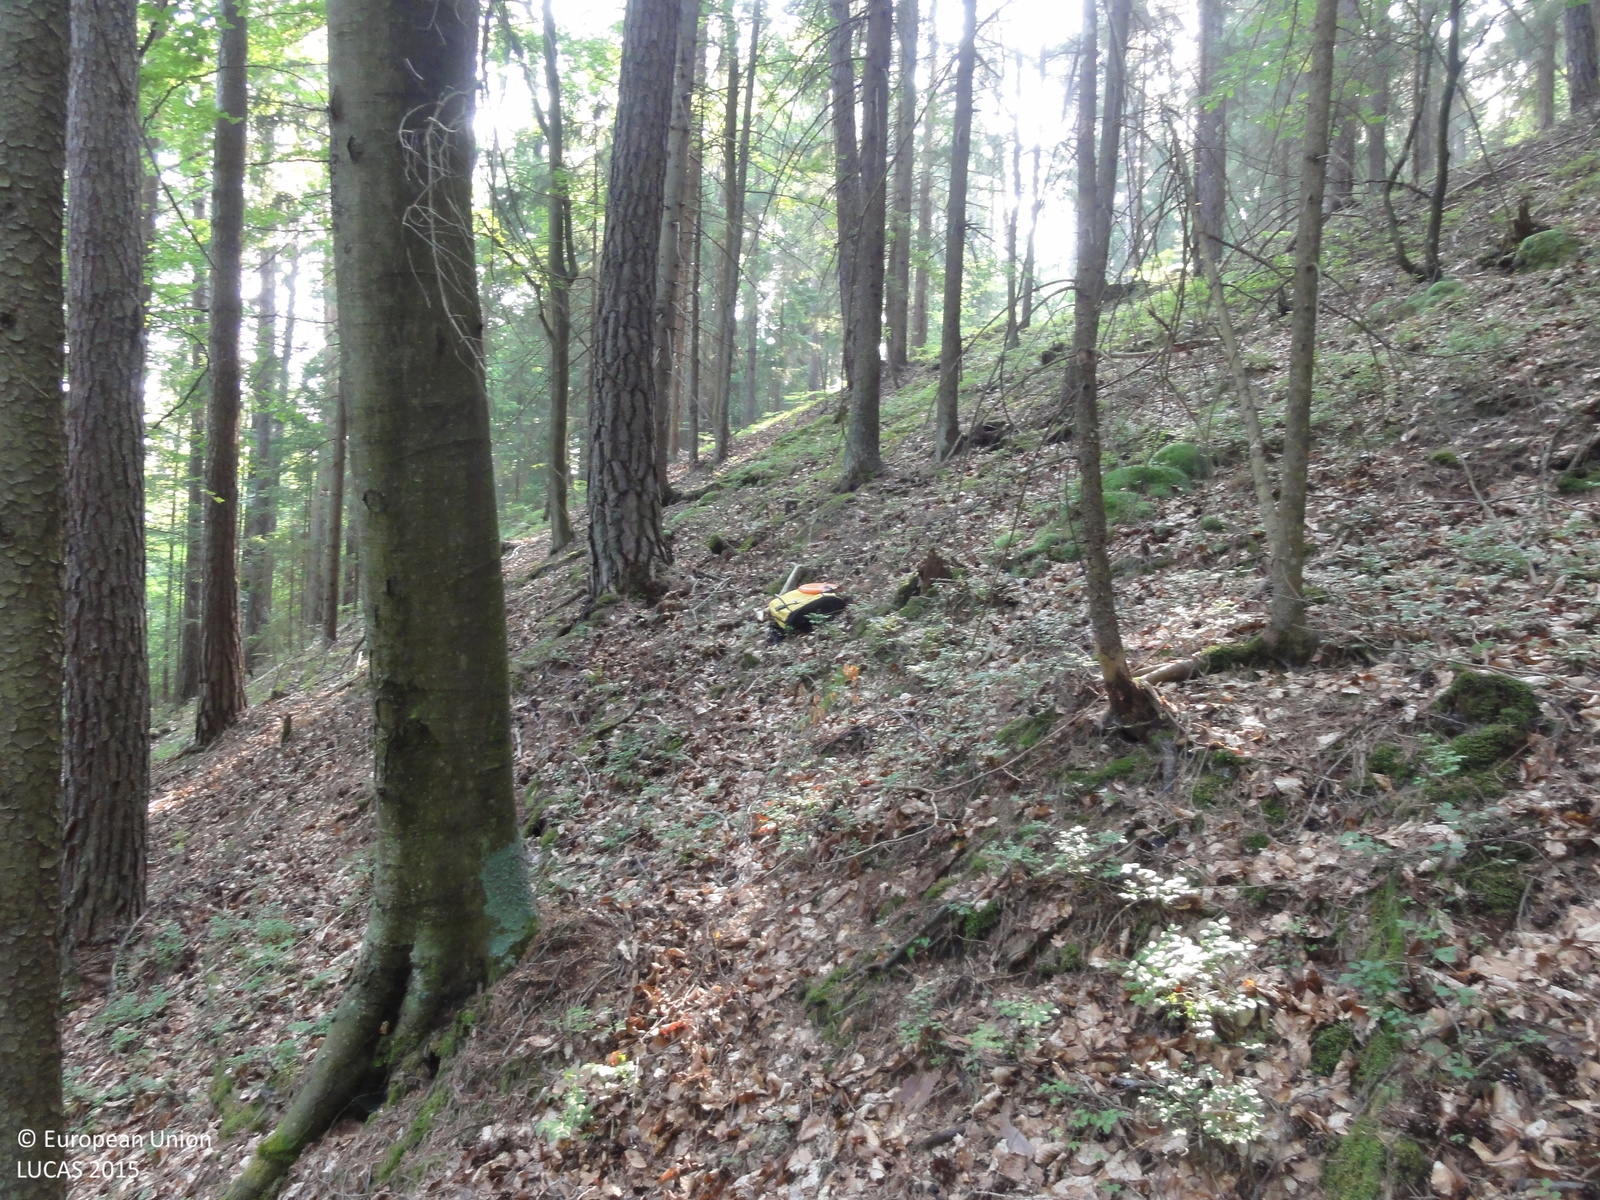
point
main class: Woodland
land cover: Other mixed woodland
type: mountainous beech forest
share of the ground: > 75 %
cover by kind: coniferous forest trees 60 %, broadleaved forest trees 40 %
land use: Forestry
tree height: > 5 m
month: July
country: SI
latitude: 46.6169
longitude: 14.9210
